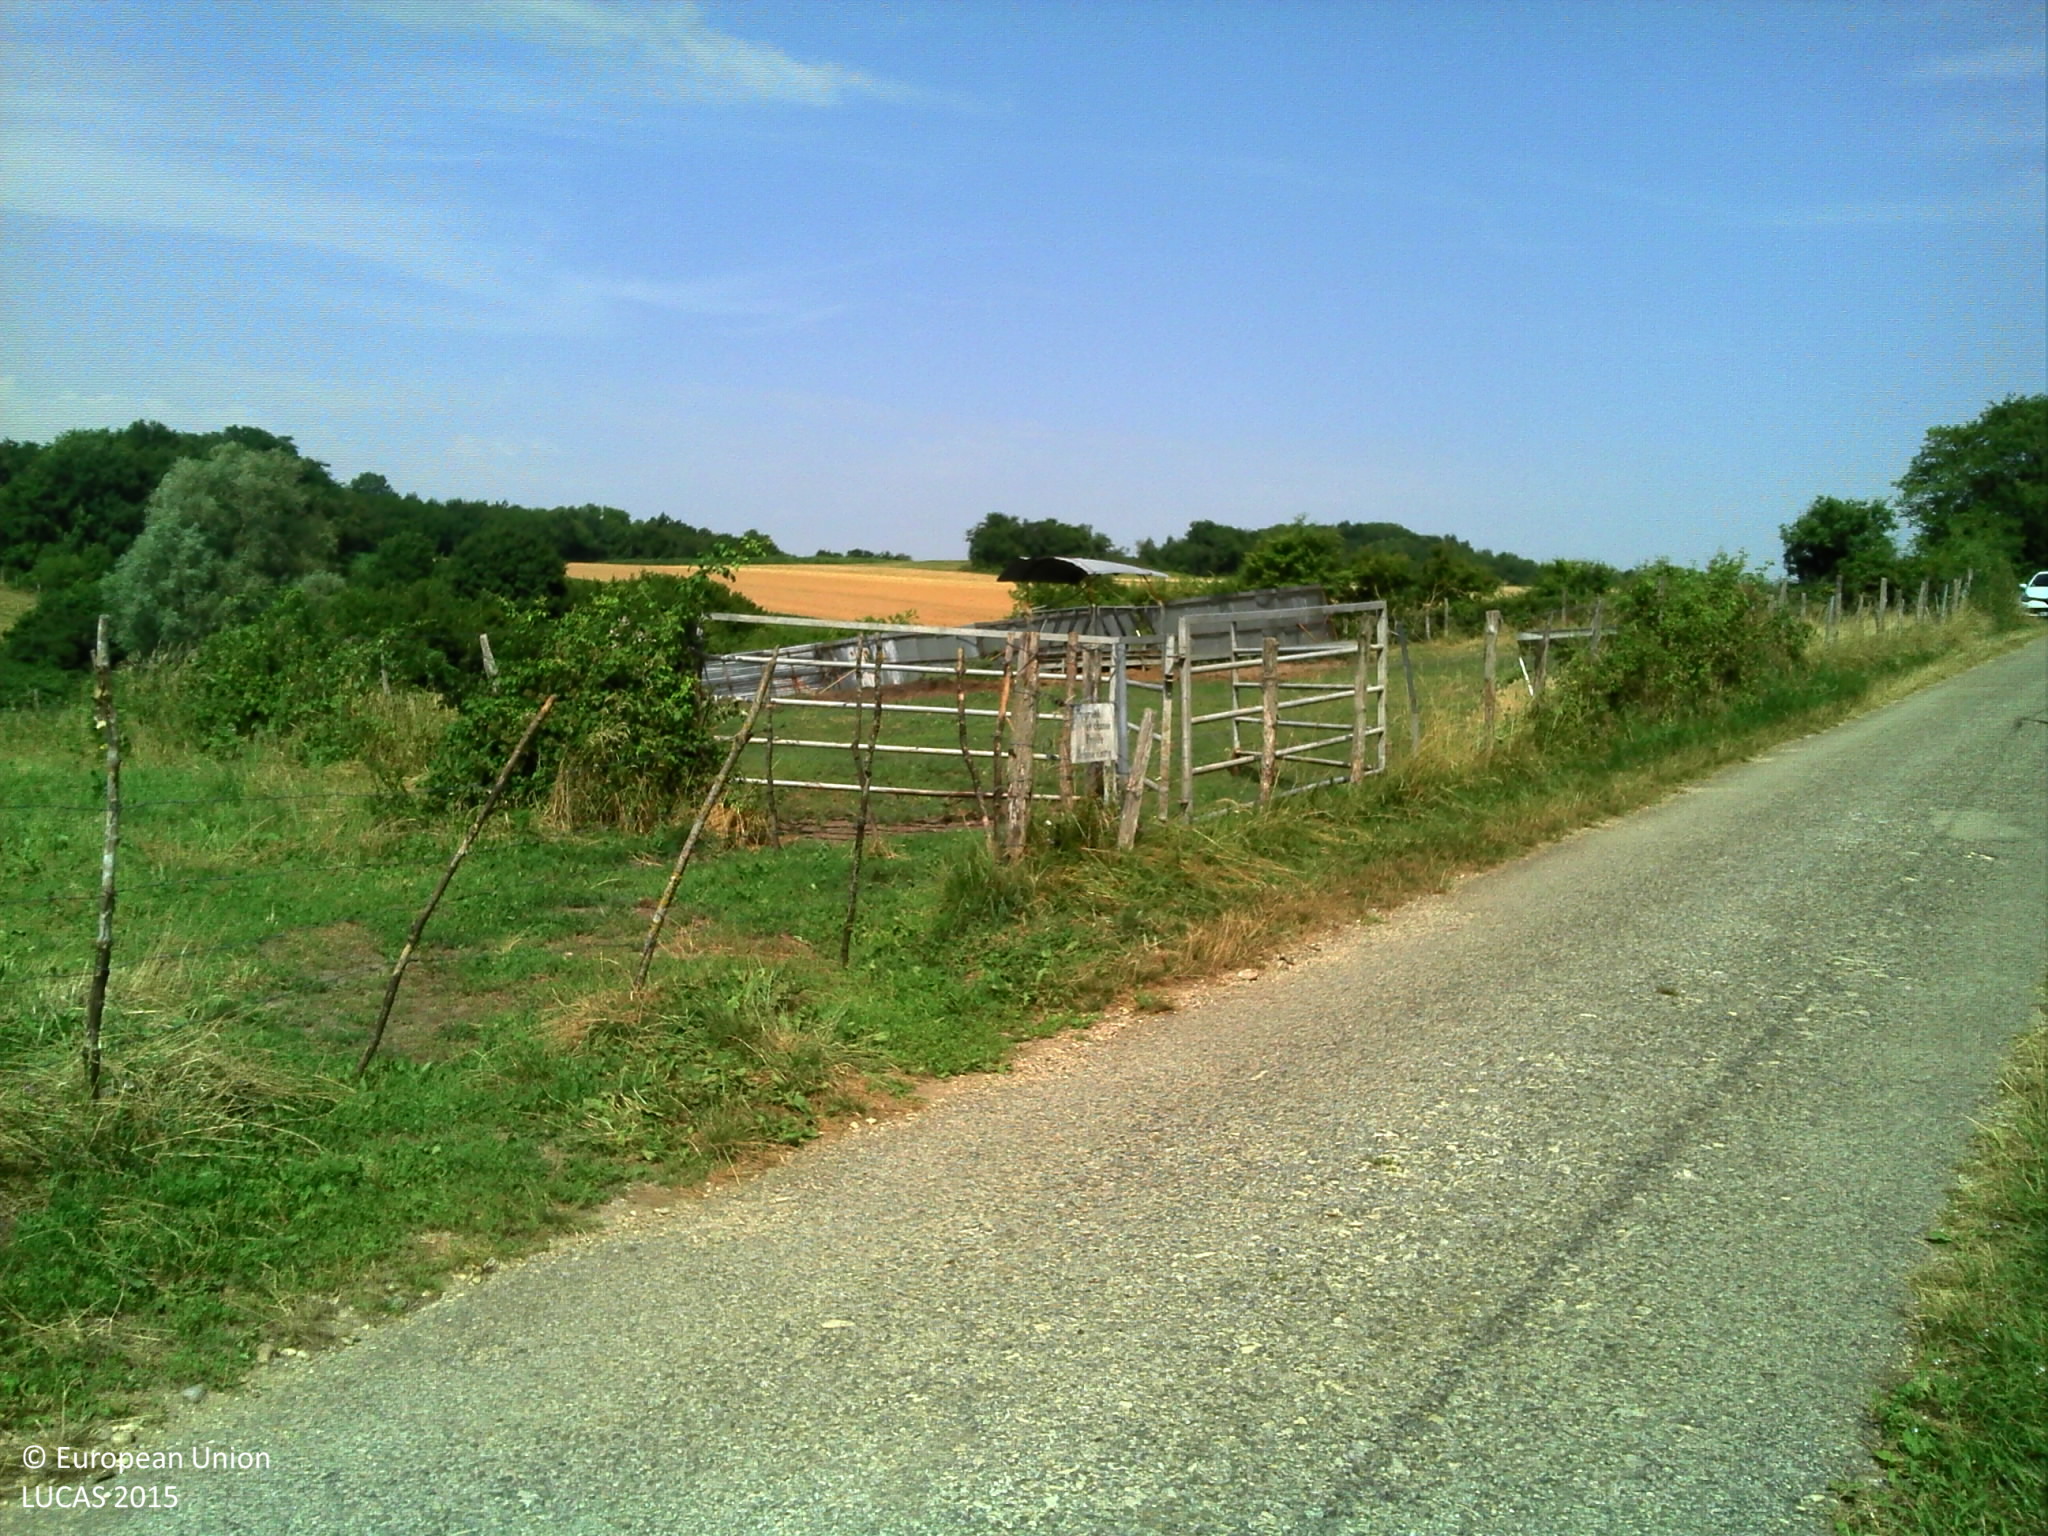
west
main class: Grassland
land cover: Grassland without tree/shrub cover
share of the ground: > 75 %
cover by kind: herbaceous plants 100 %
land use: Agriculture (excluding fallow land and kitchen gardens)
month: July
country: FR
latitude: 45.7275
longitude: 5.3654
